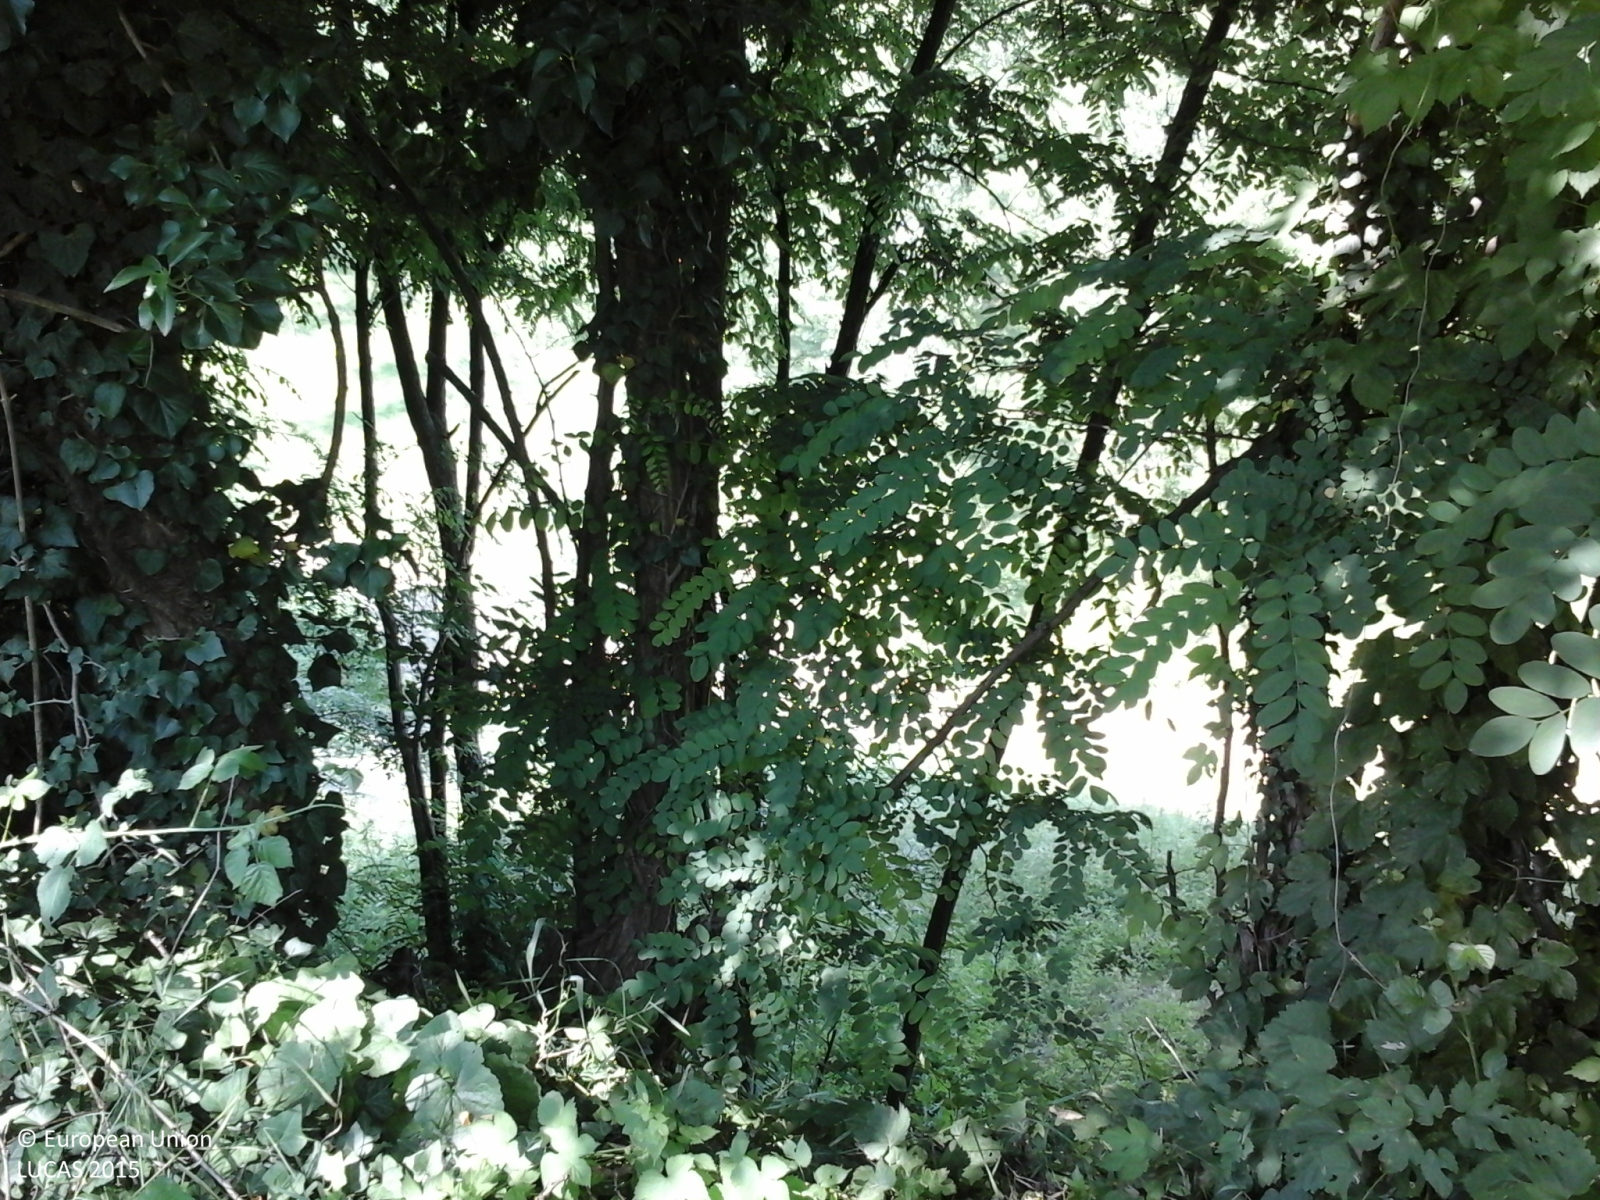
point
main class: Woodland
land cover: Broadleaved woodland
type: thermophilous deciduous forest
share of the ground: > 75 %
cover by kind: broadleaved forest trees 100 %
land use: Forestry
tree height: > 5 m
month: June
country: IT
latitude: 45.5255
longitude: 8.2232
